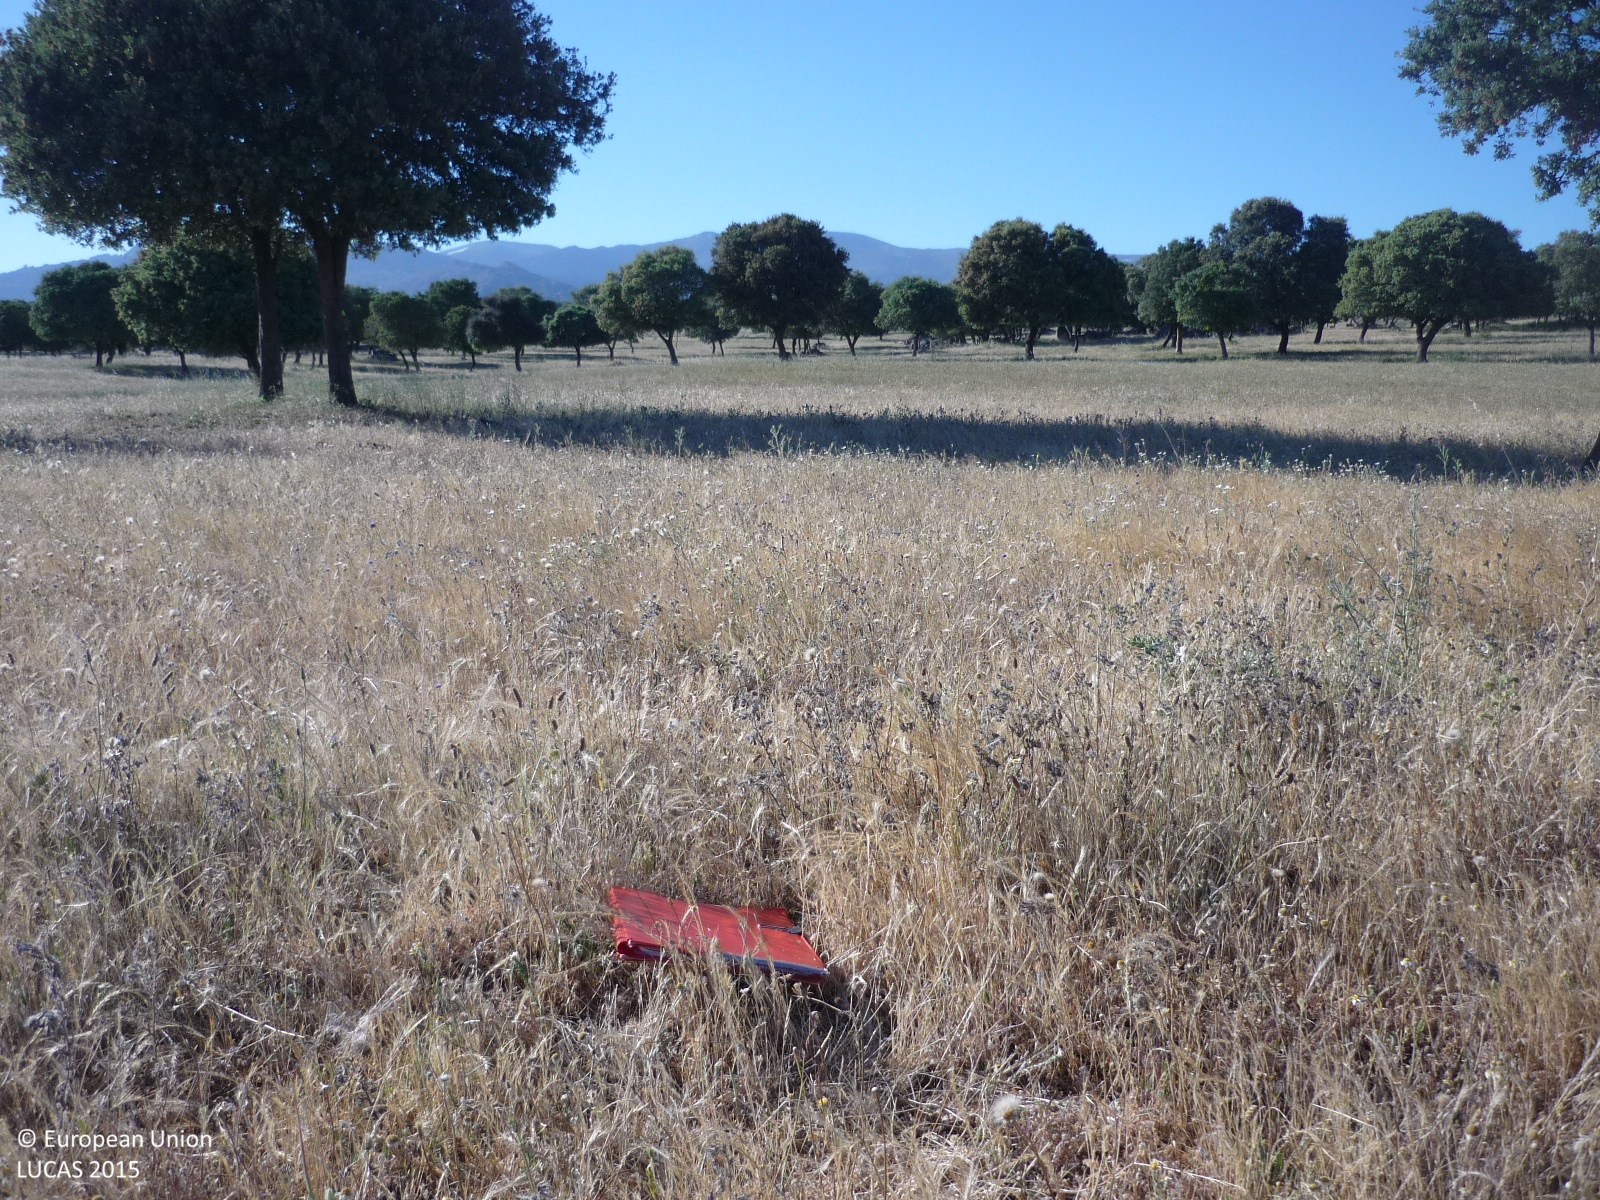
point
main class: Grassland
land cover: Grassland with sparse tree/shrub cover
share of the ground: > 75 %
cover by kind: herbaceous plants 90 %, broadleaved forest trees 5 %, shrubs 5 %
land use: Agriculture (excluding fallow land and kitchen gardens)
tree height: < 5 m
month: May
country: ES
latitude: 40.6869
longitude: -3.8758
